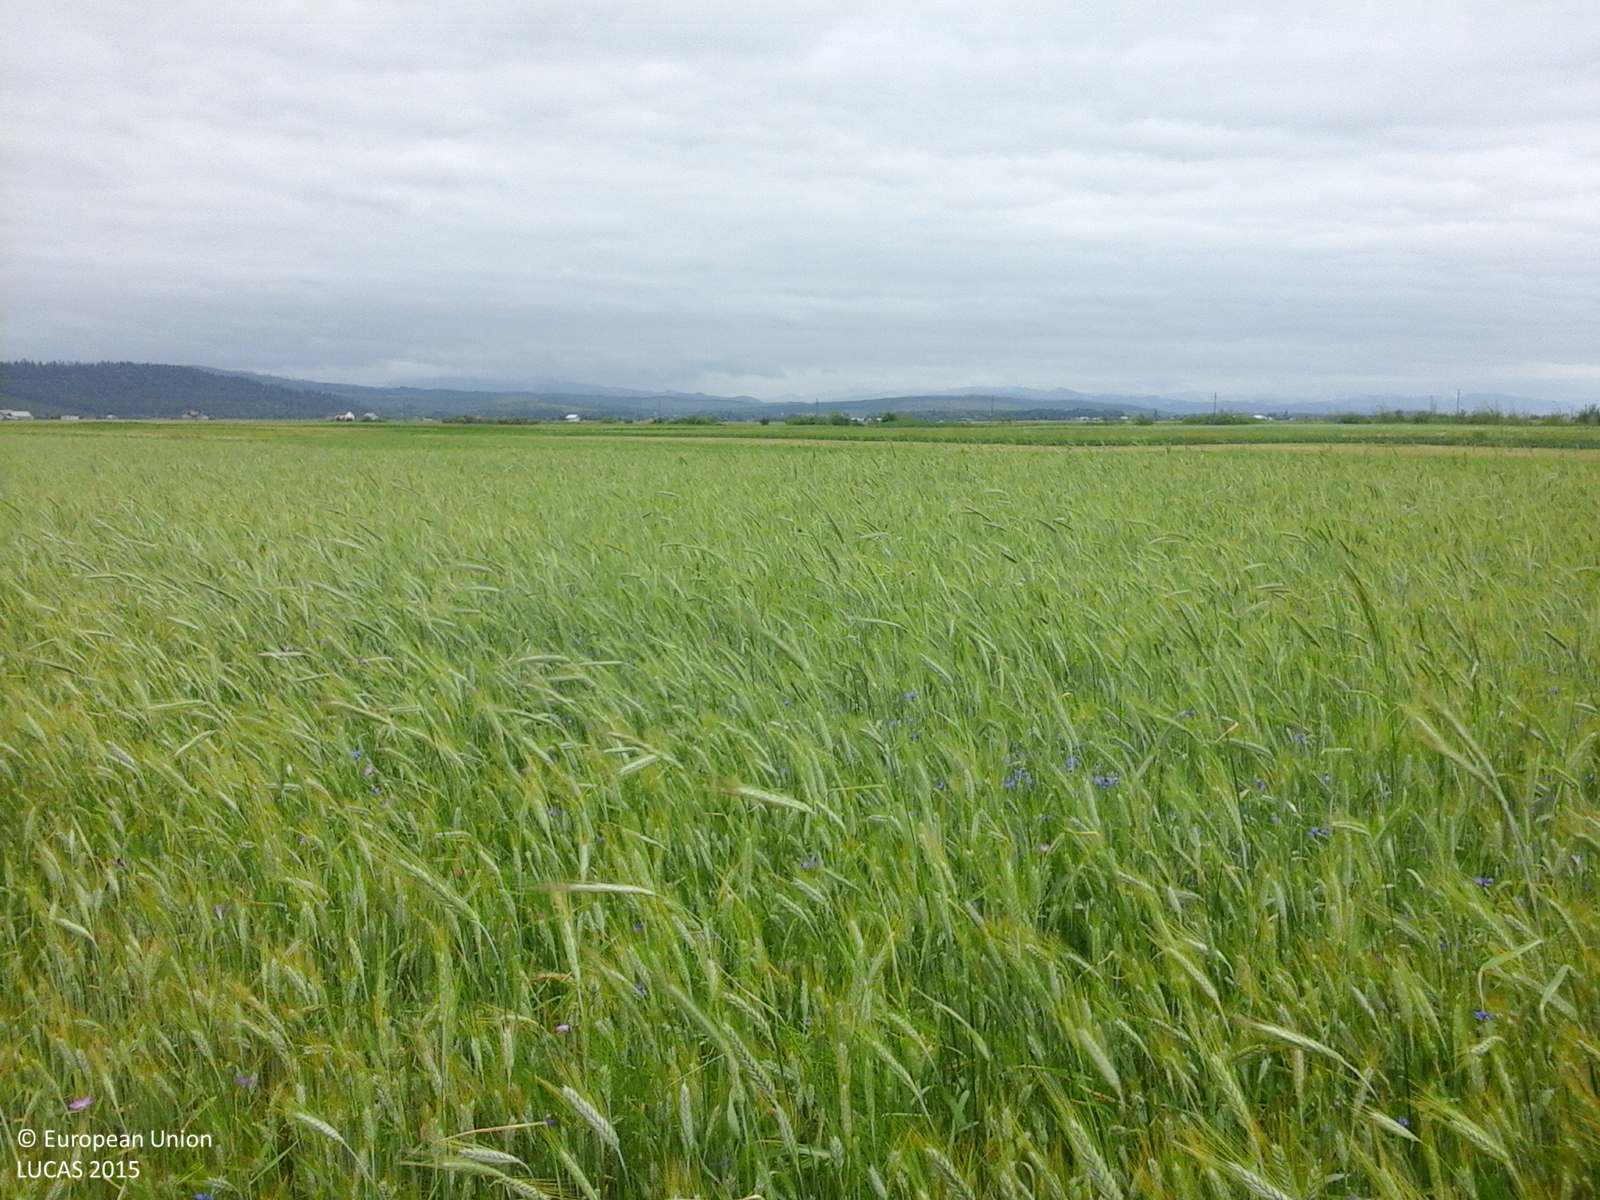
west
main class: Cropland
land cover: Common wheat
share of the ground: > 75 %
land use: Agriculture (excluding fallow land and kitchen gardens)
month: June
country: RO
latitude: 47.4343
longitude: 26.2167
